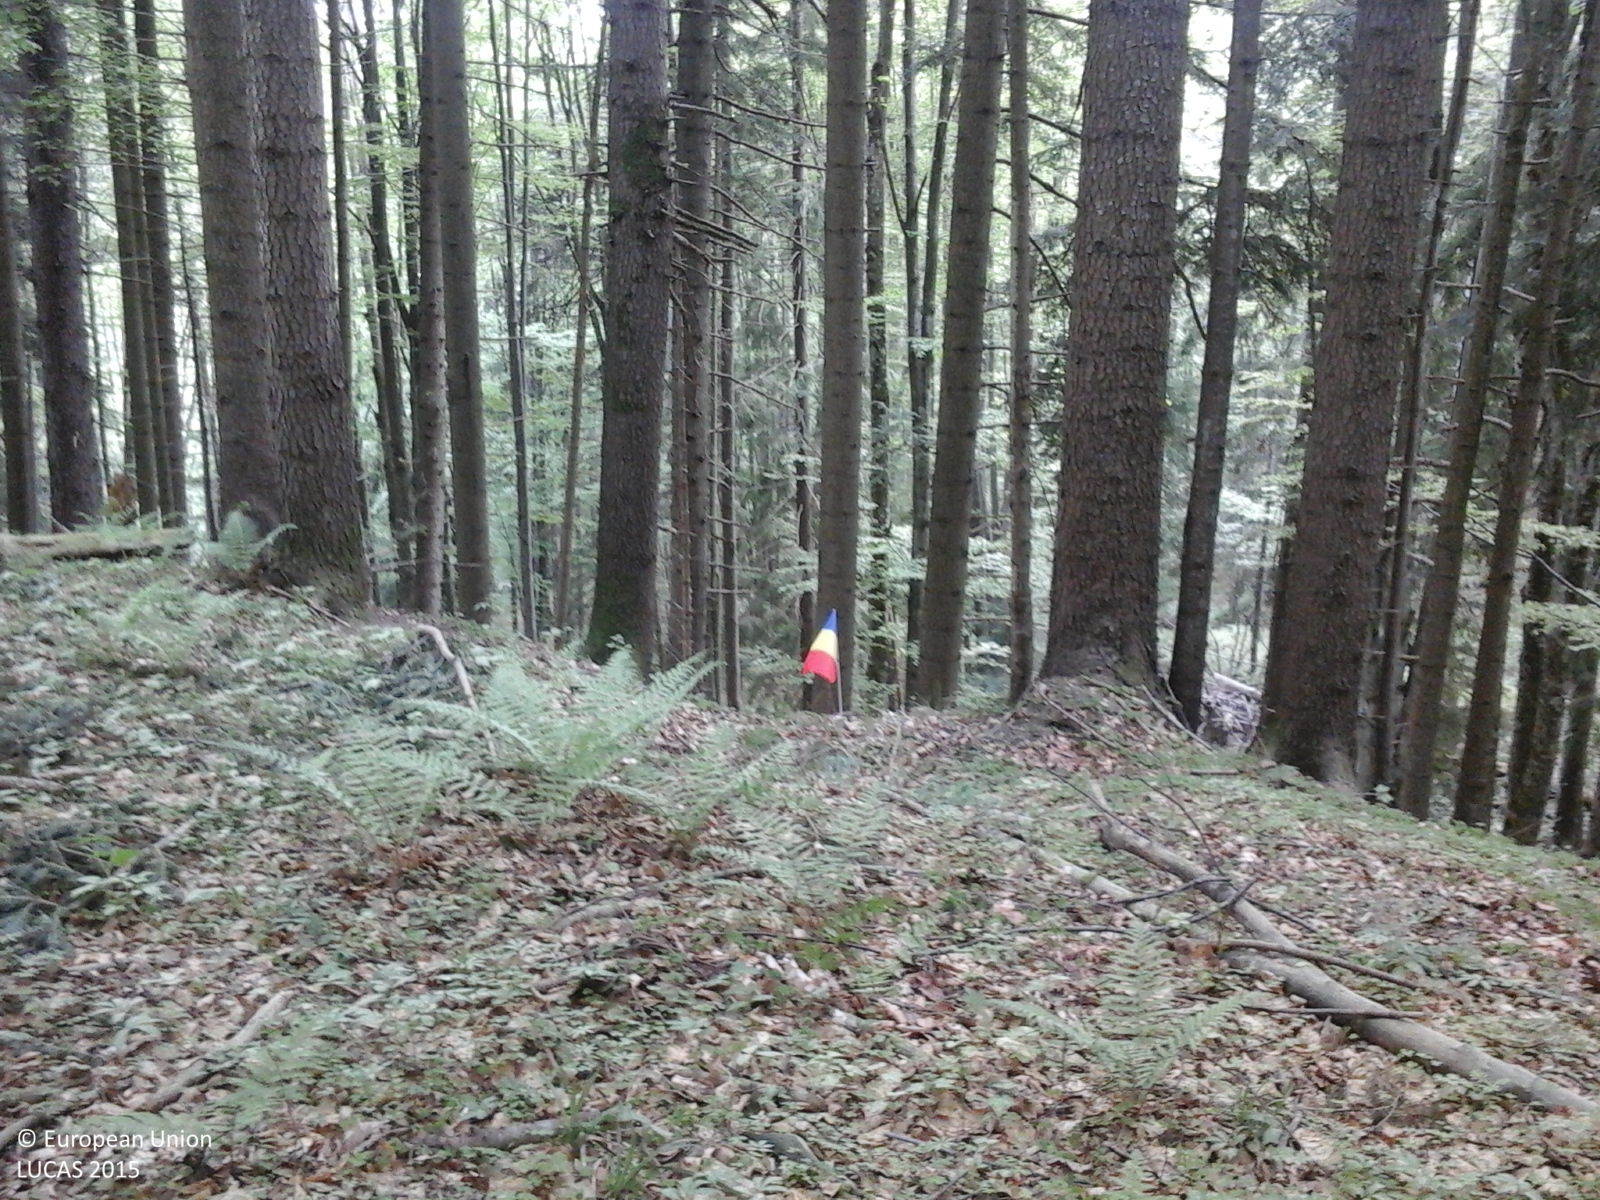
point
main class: Woodland
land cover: Spruce dominated mixed woodland
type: hemiboreal forest and nemoral coniferous forest and mixed broadleaved-coniferous forest
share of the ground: > 75 %
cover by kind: coniferous forest trees 60 %, broadleaved forest trees 40 %
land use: Forestry
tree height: > 5 m
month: May
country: RO
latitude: 45.5494
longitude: 26.2983
